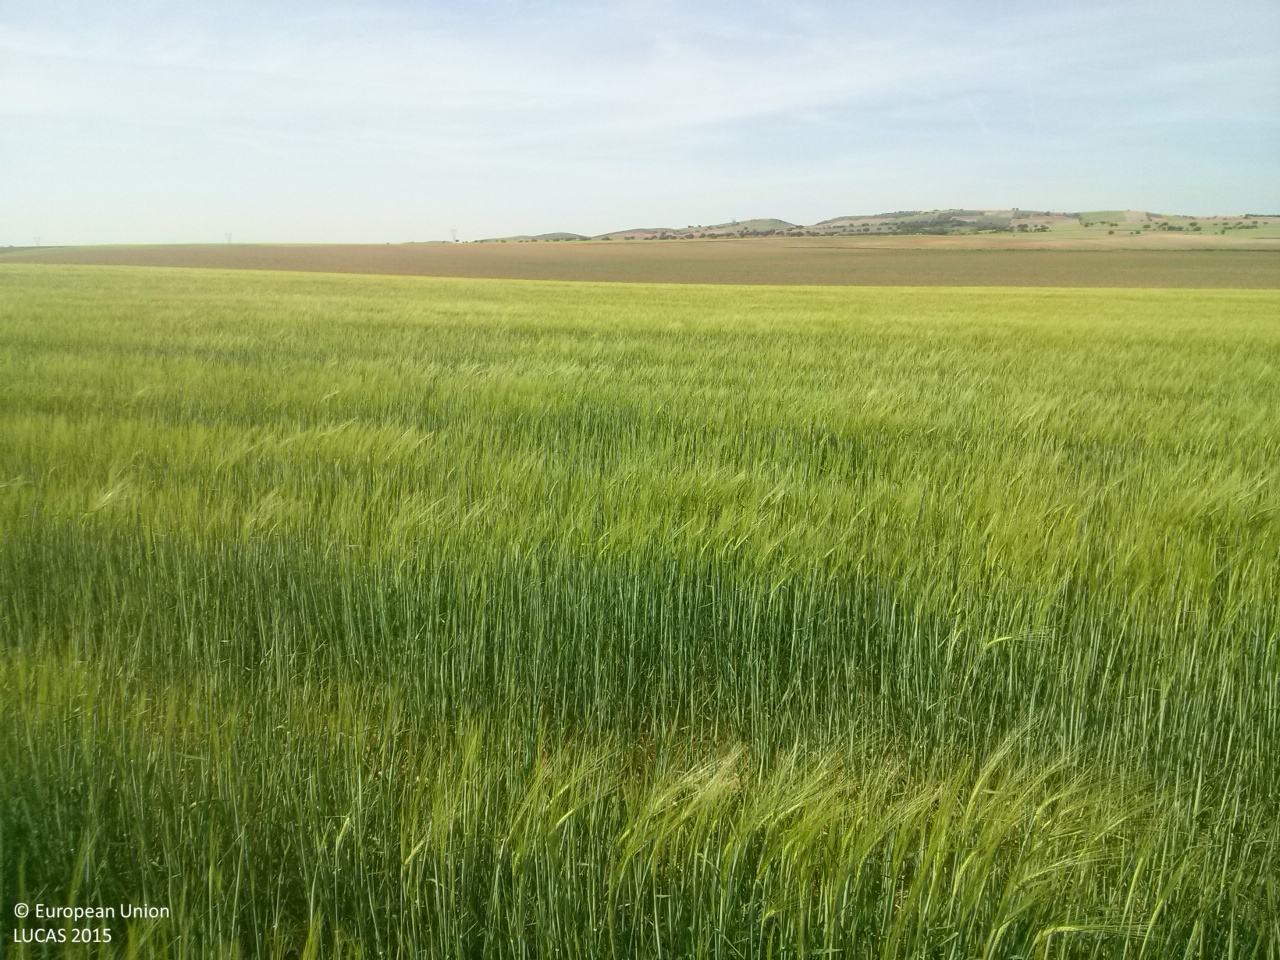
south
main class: Cropland
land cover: Barley
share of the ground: > 75 %
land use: Agriculture (excluding fallow land and kitchen gardens)
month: May
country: ES
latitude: 39.8471
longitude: -2.6519
